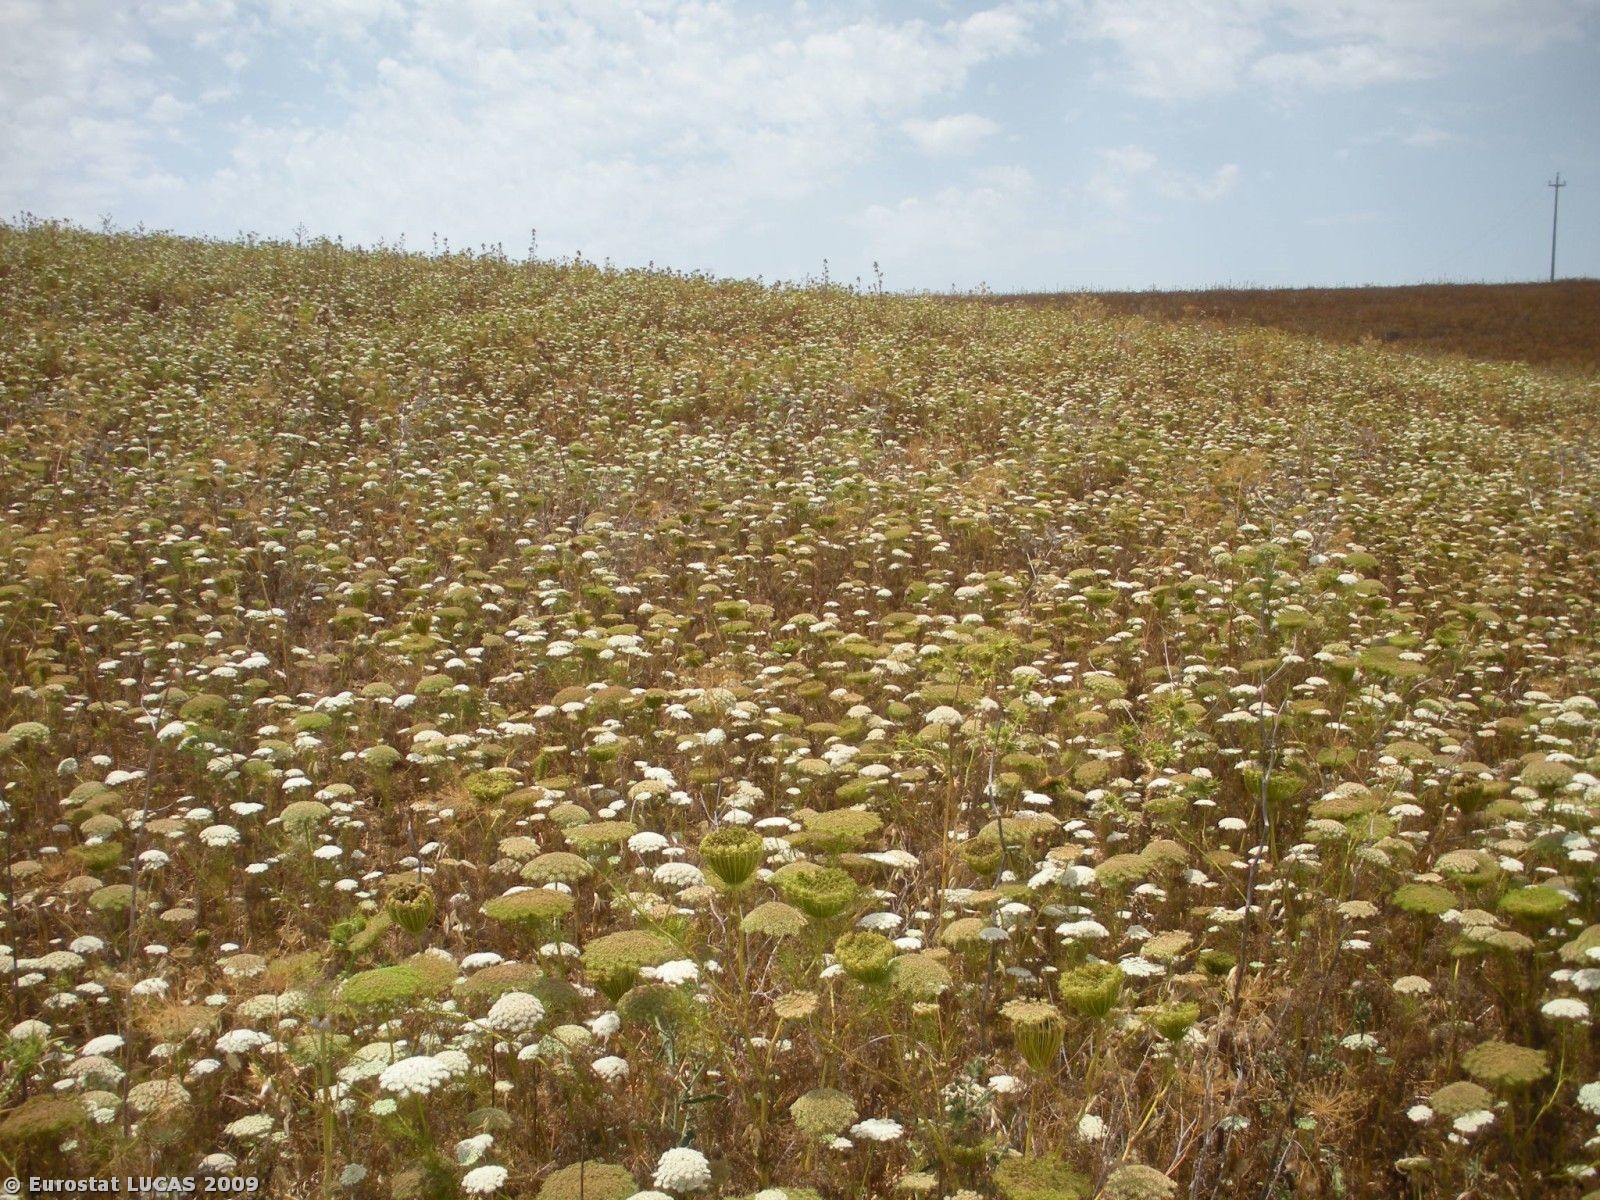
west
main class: Grassland
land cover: Grassland without tree/shrub cover
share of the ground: > 75 %
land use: Agriculture (excluding fallow land and kitchen gardens)
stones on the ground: > 50 %
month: July
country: IT
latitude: 37.8747
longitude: 12.6295
